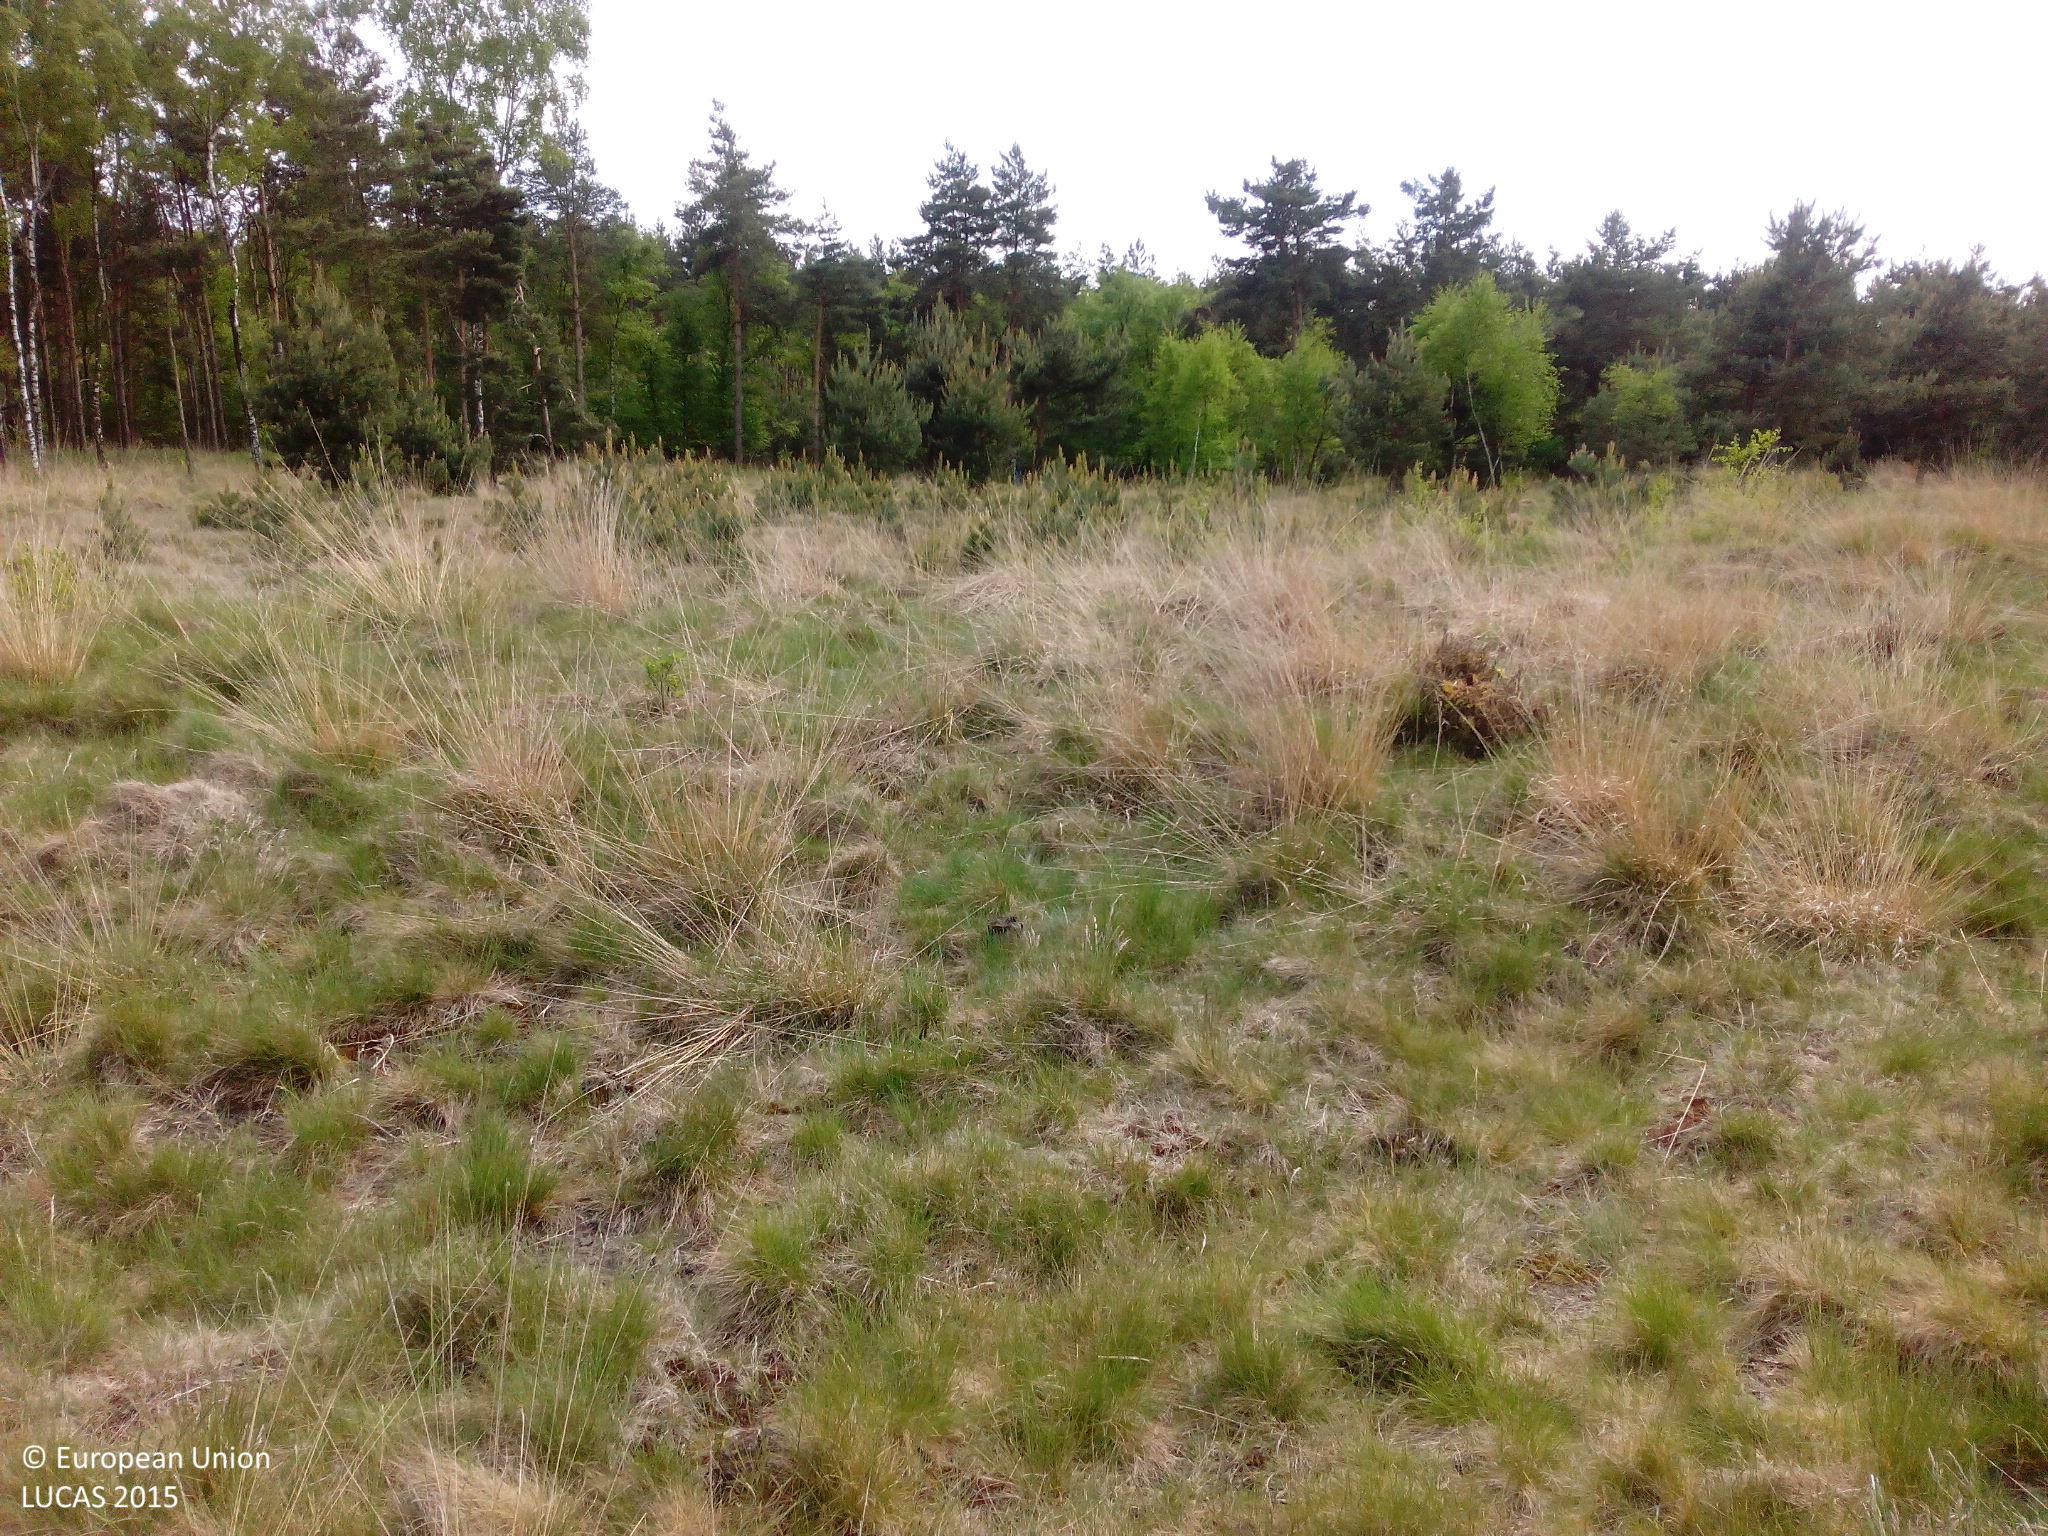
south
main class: Grassland
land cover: Grassland without tree/shrub cover
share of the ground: > 75 %
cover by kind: herbaceous plants 100 %
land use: Air transport
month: May
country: NL
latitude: 51.2518
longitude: 5.5998
